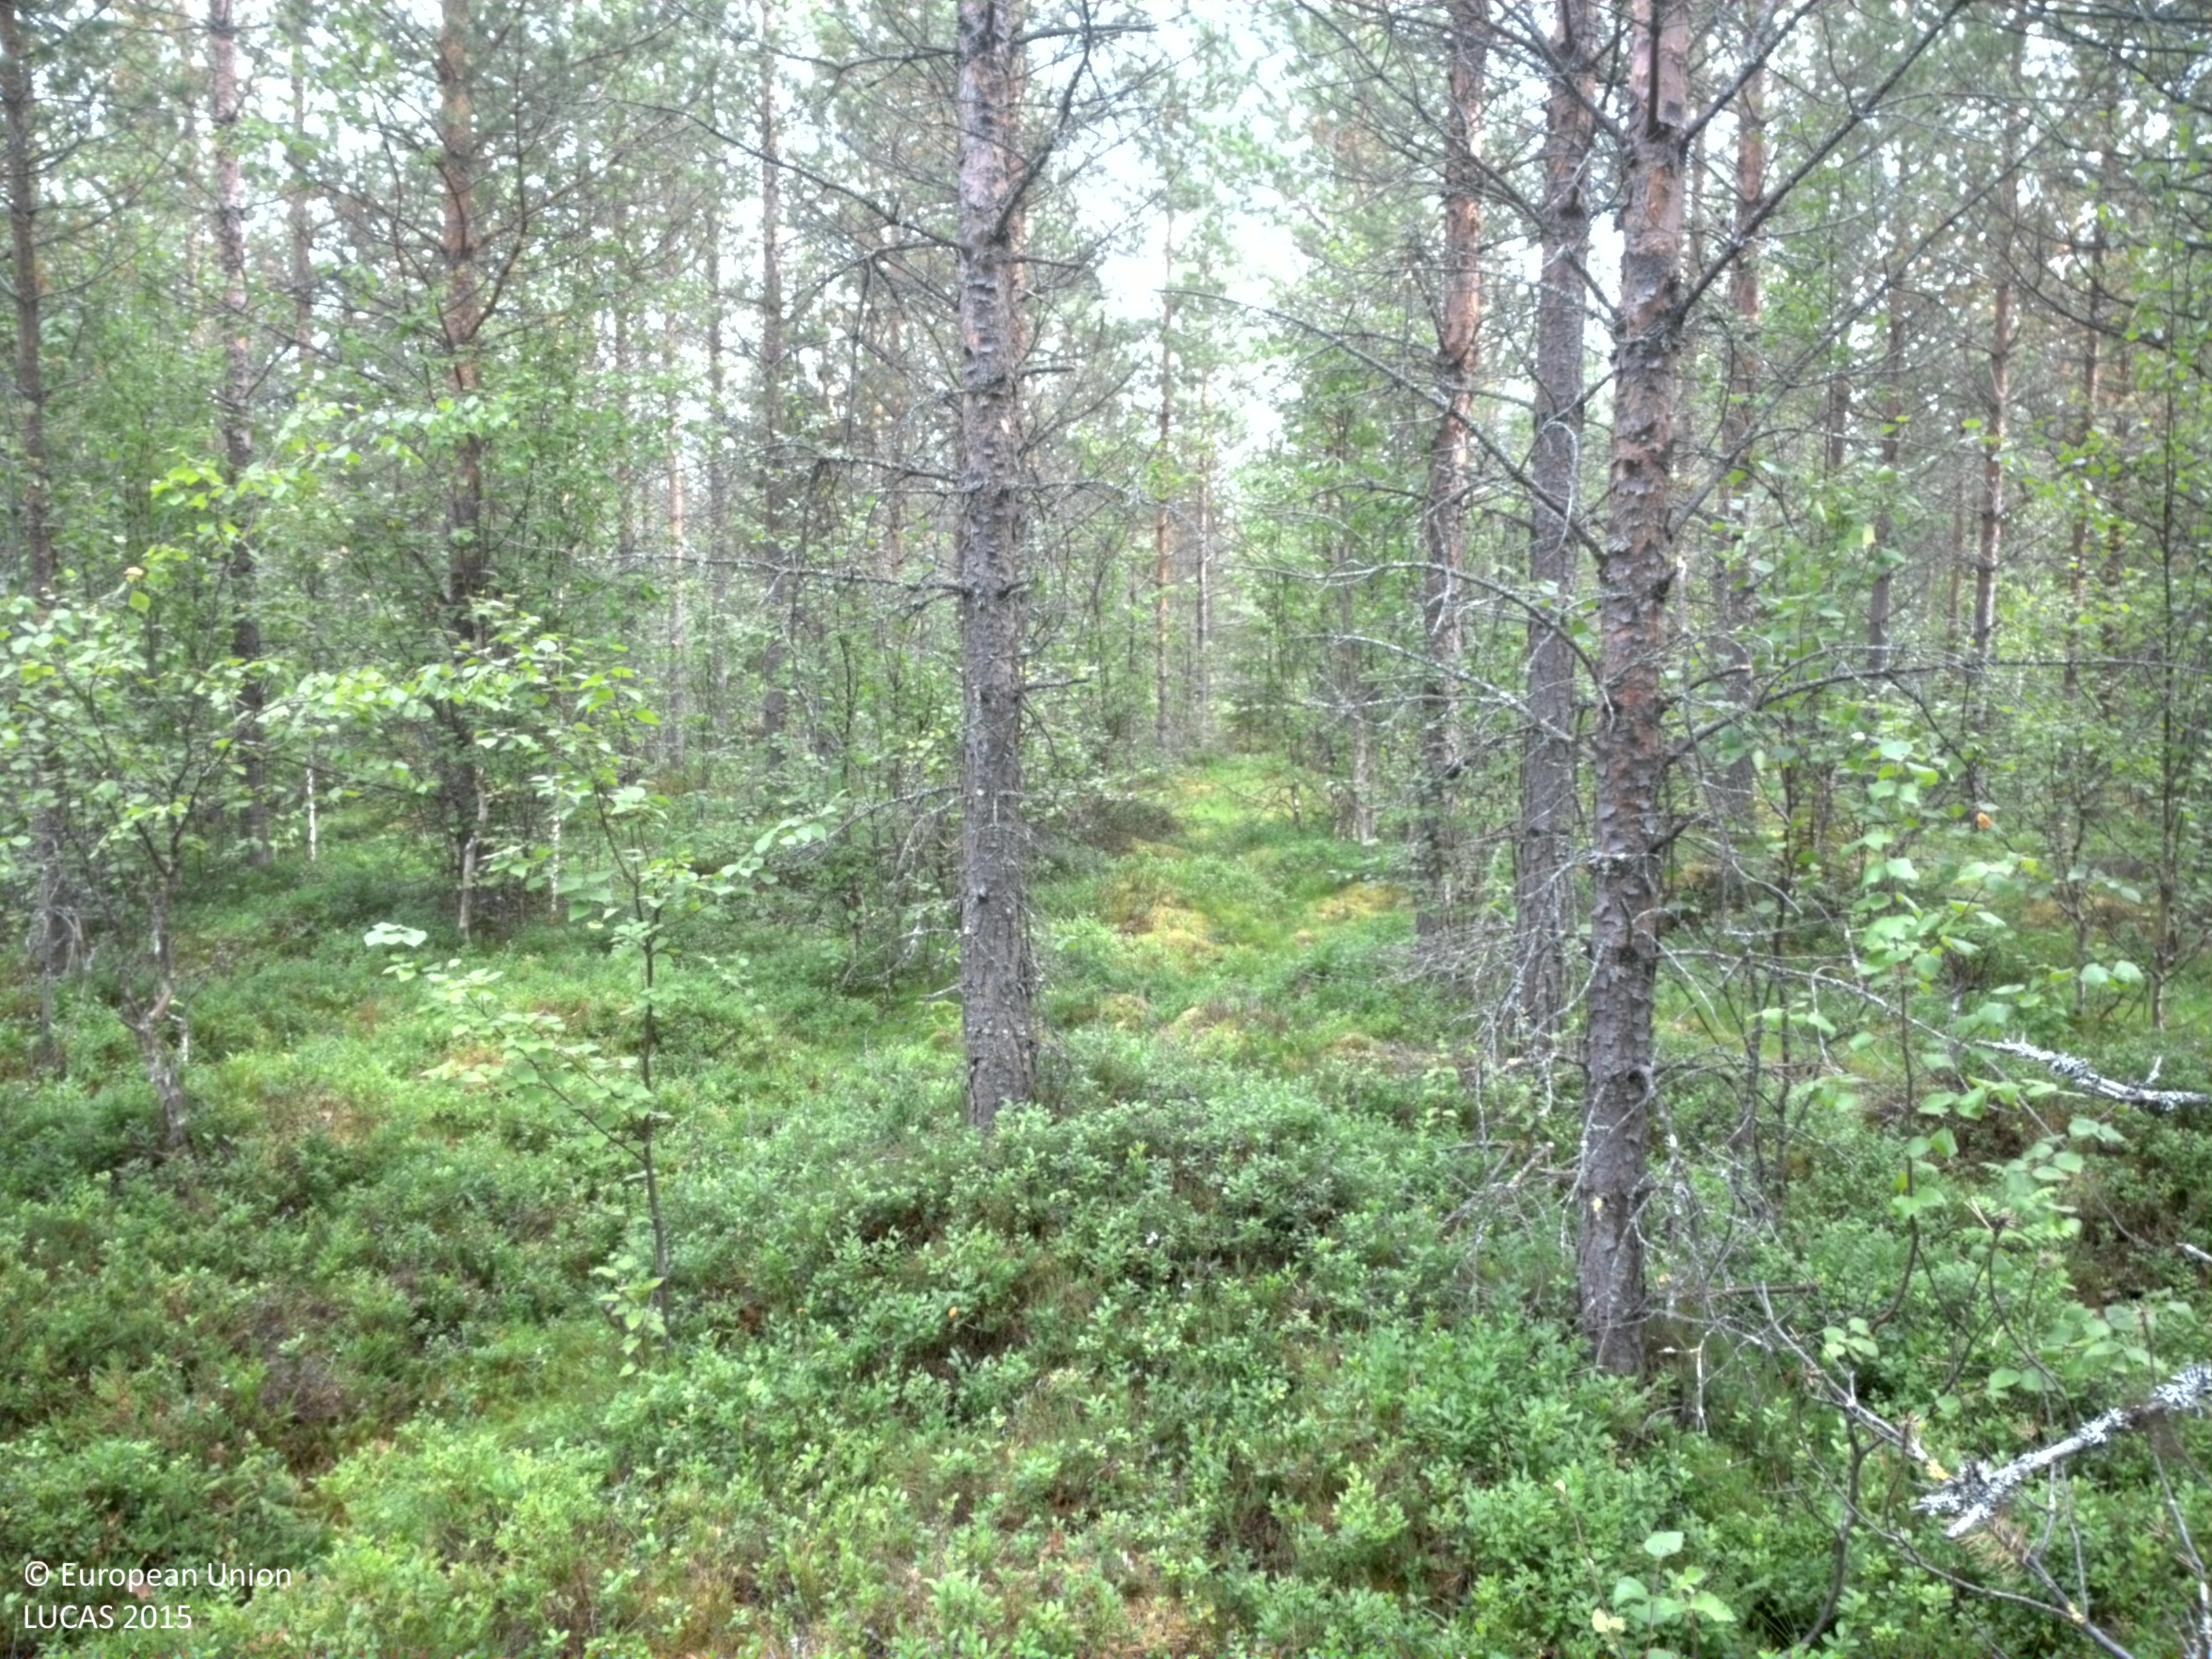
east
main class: Woodland
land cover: Pine dominated mixed woodland
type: boreal forest
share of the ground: 50 - 75 %
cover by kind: coniferous forest trees 45 %, shrubs 30 %, broadleaved forest trees 15 %, lichens and mosses 10 %
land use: Forestry
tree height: > 5 m
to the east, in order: Pine dominated mixed woodland; Other coniferous woodland; Ditches and canals; Pine dominated coniferous woodland
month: August
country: SE
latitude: 64.5371
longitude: 20.2946
